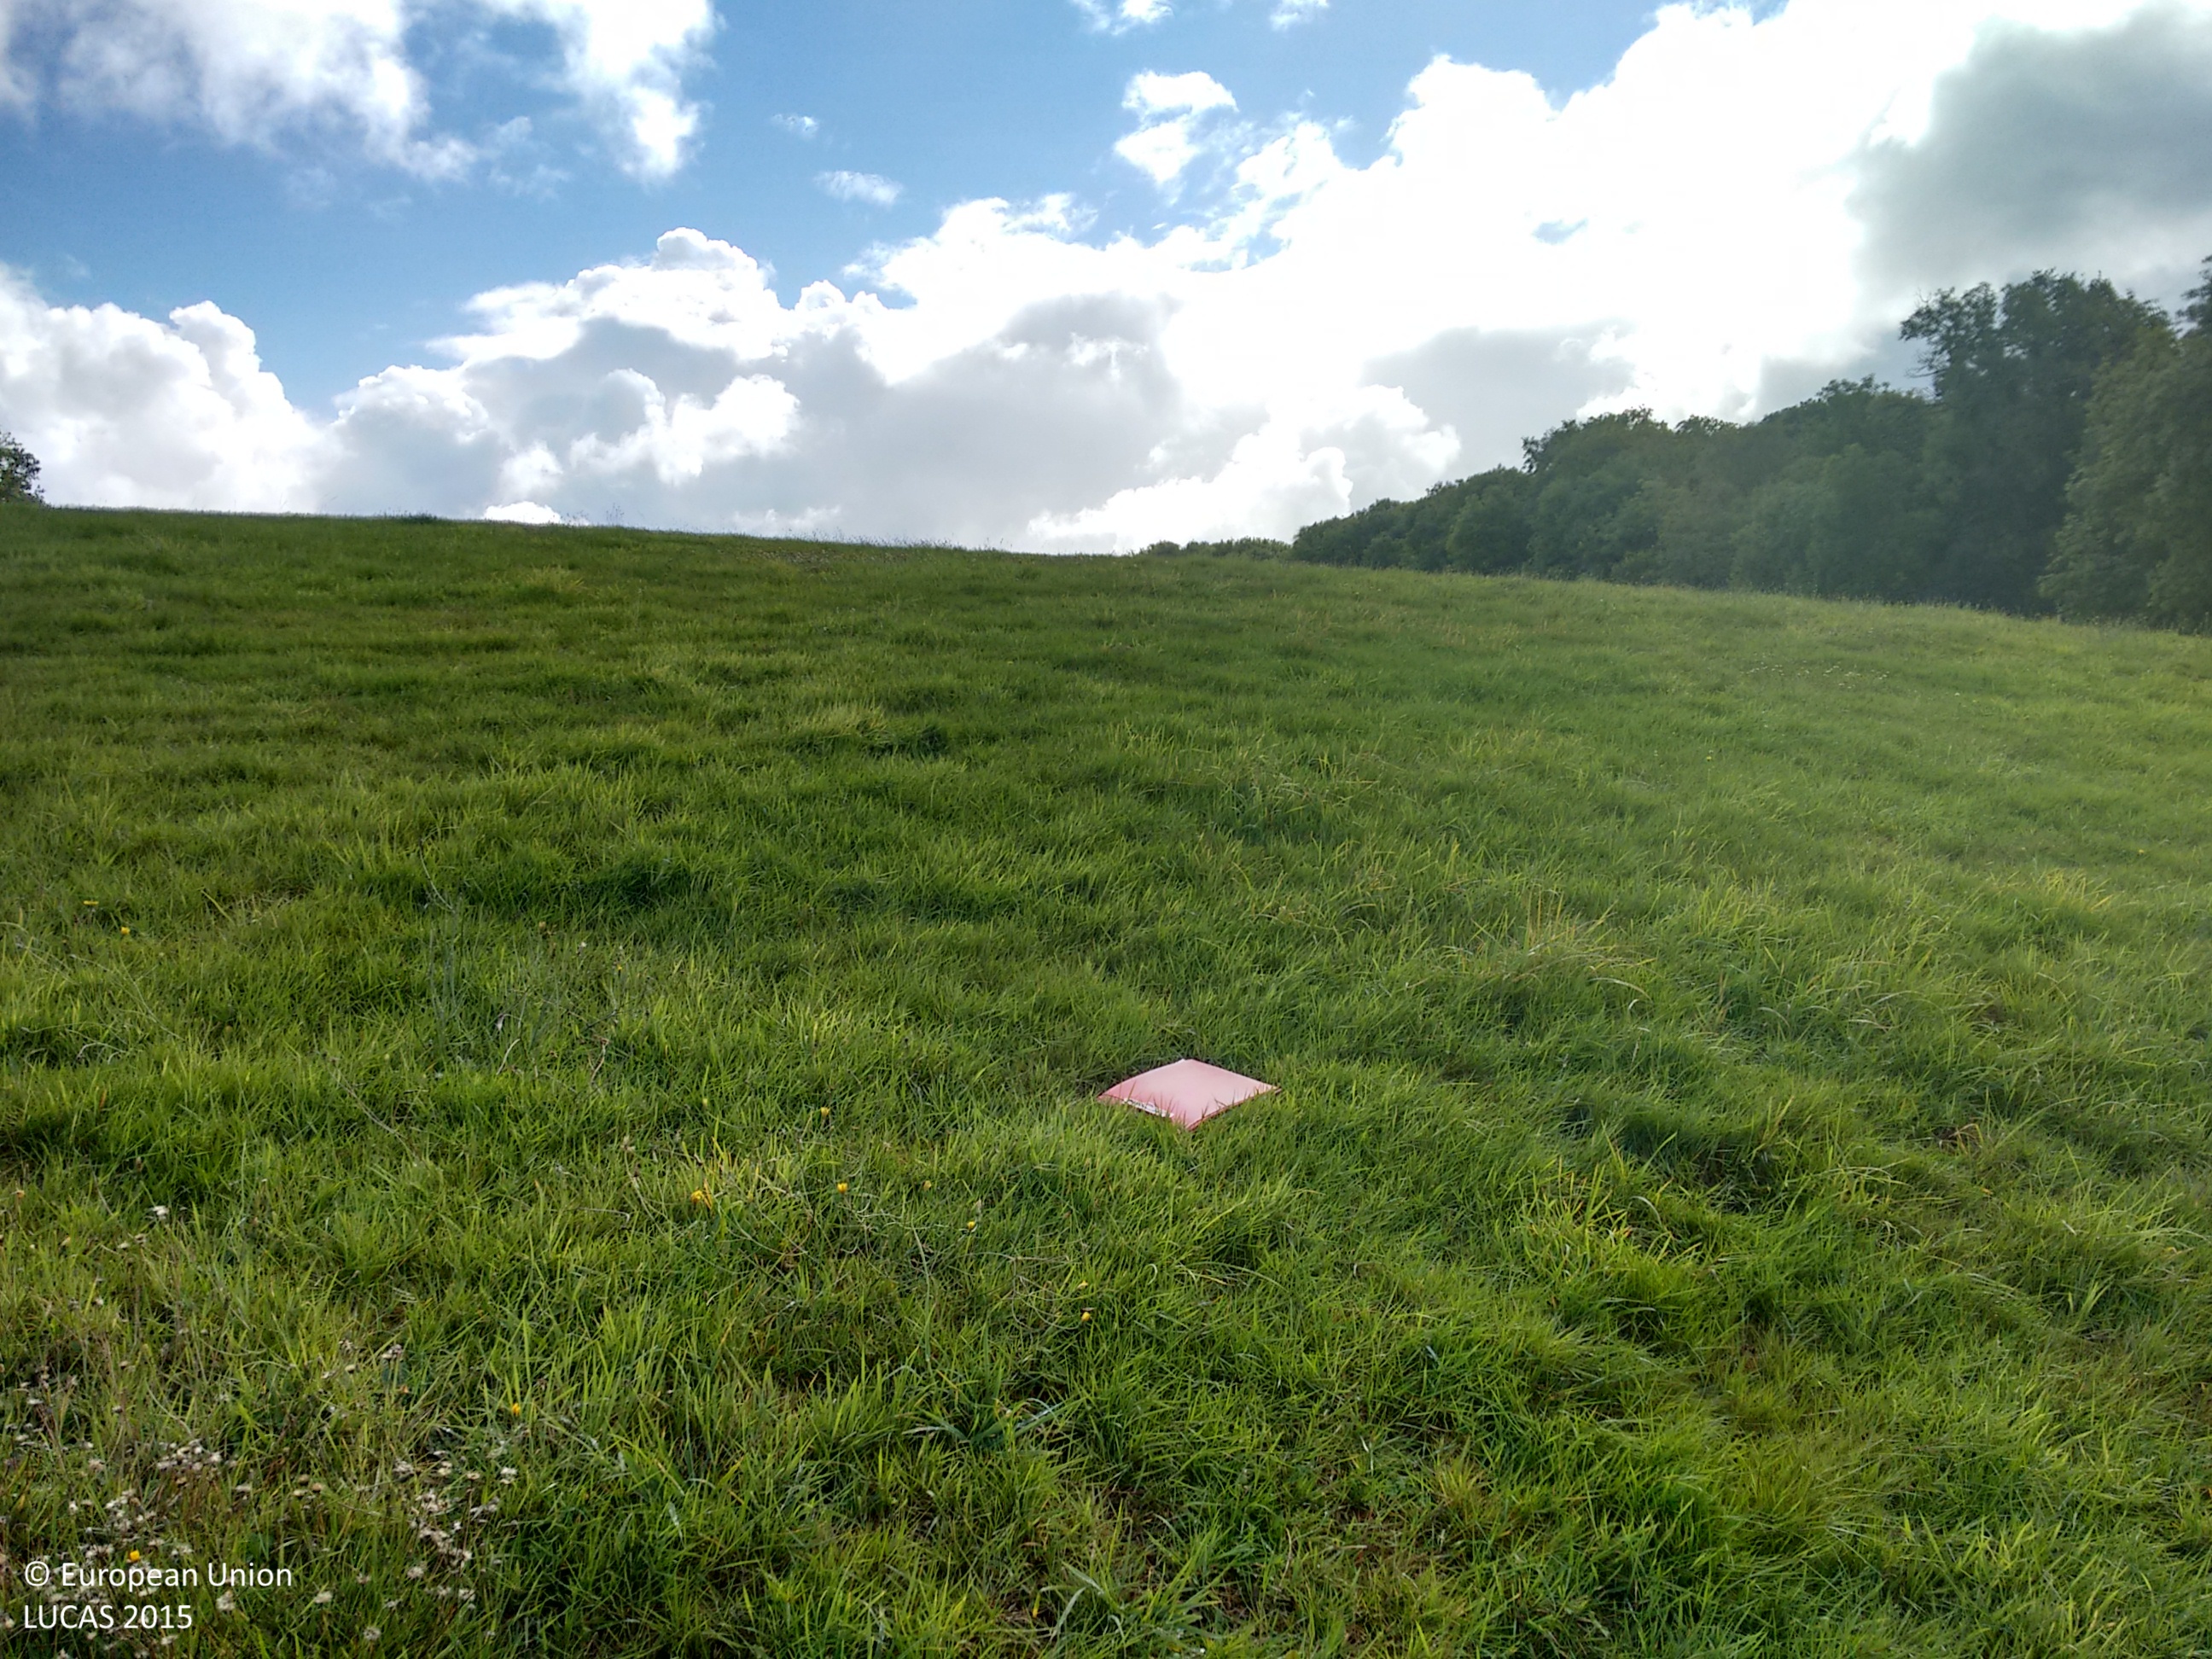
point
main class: Grassland
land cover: Grassland without tree/shrub cover
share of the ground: > 75 %
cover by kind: herbaceous plants 100 %
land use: Agriculture (excluding fallow land and kitchen gardens)
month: September
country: GB
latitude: 50.7390
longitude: -3.8501
